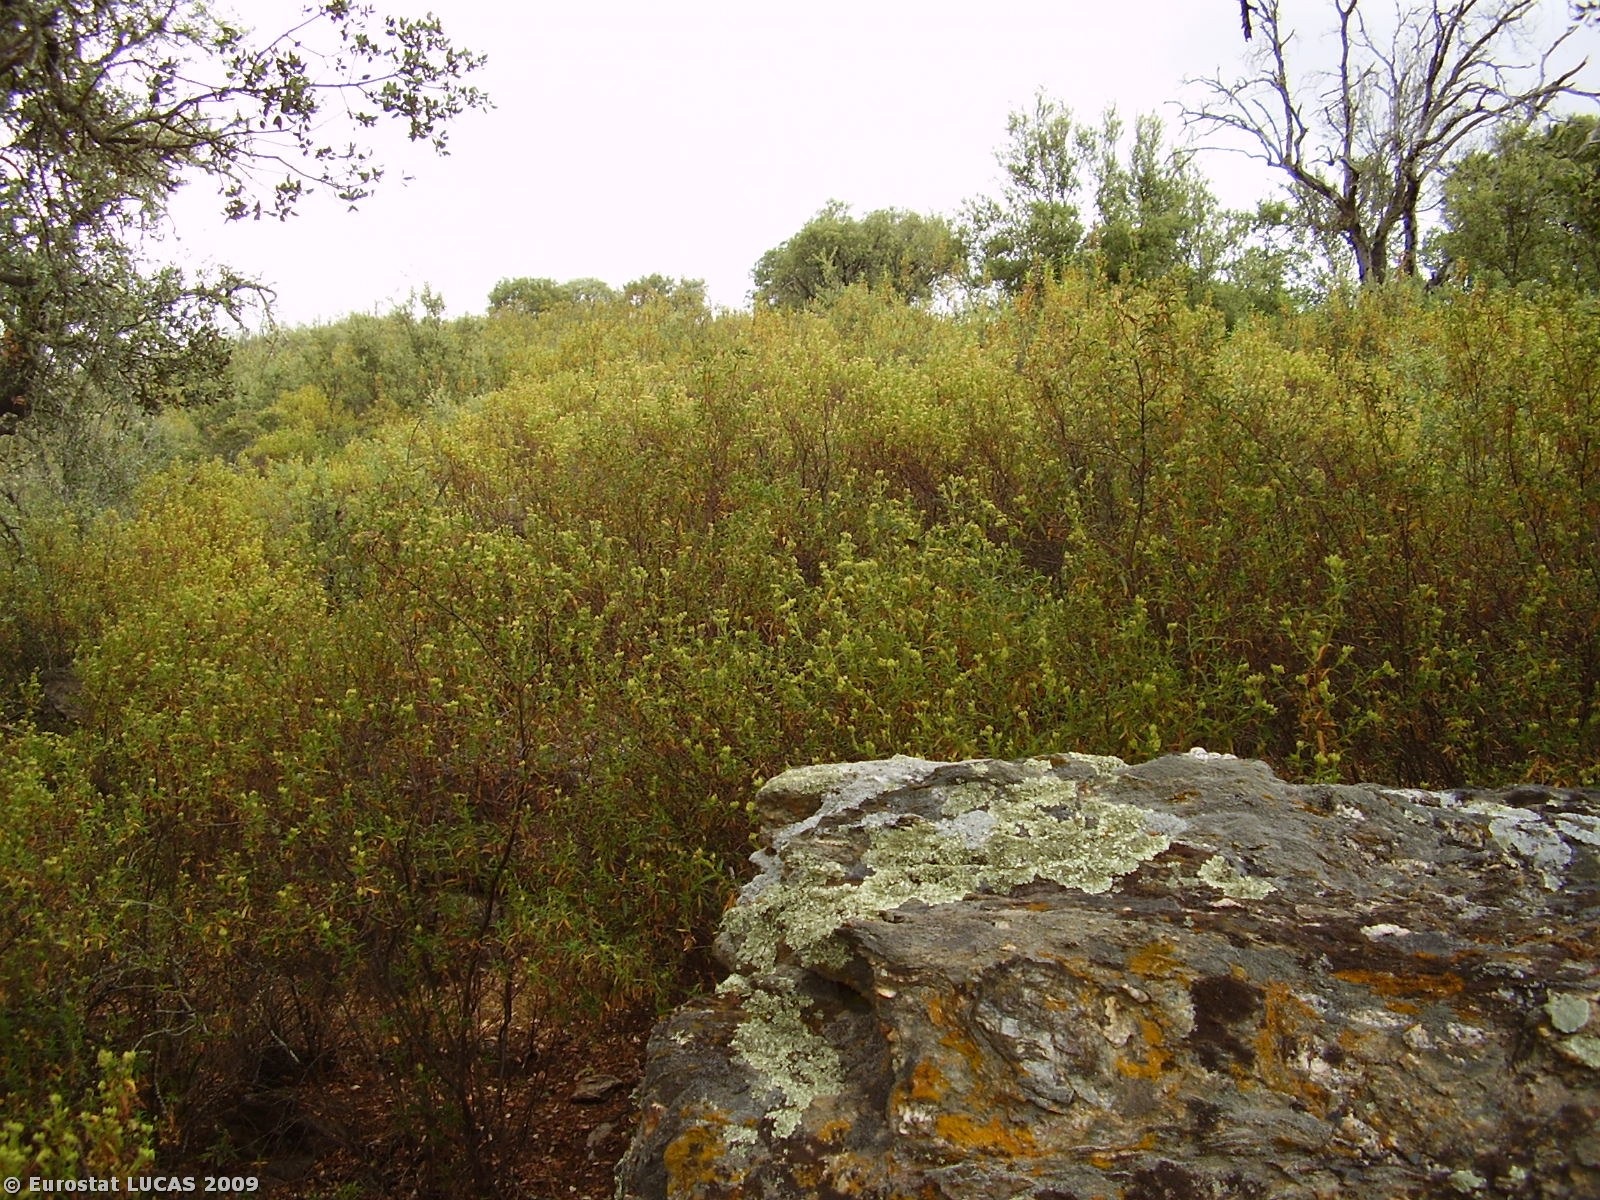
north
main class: Shrubland
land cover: Shrubland with sparse tree cover
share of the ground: 50 - 75 %
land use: Fallow land
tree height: > 5 m
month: May
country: PT
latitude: 37.8242
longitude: -7.7325
